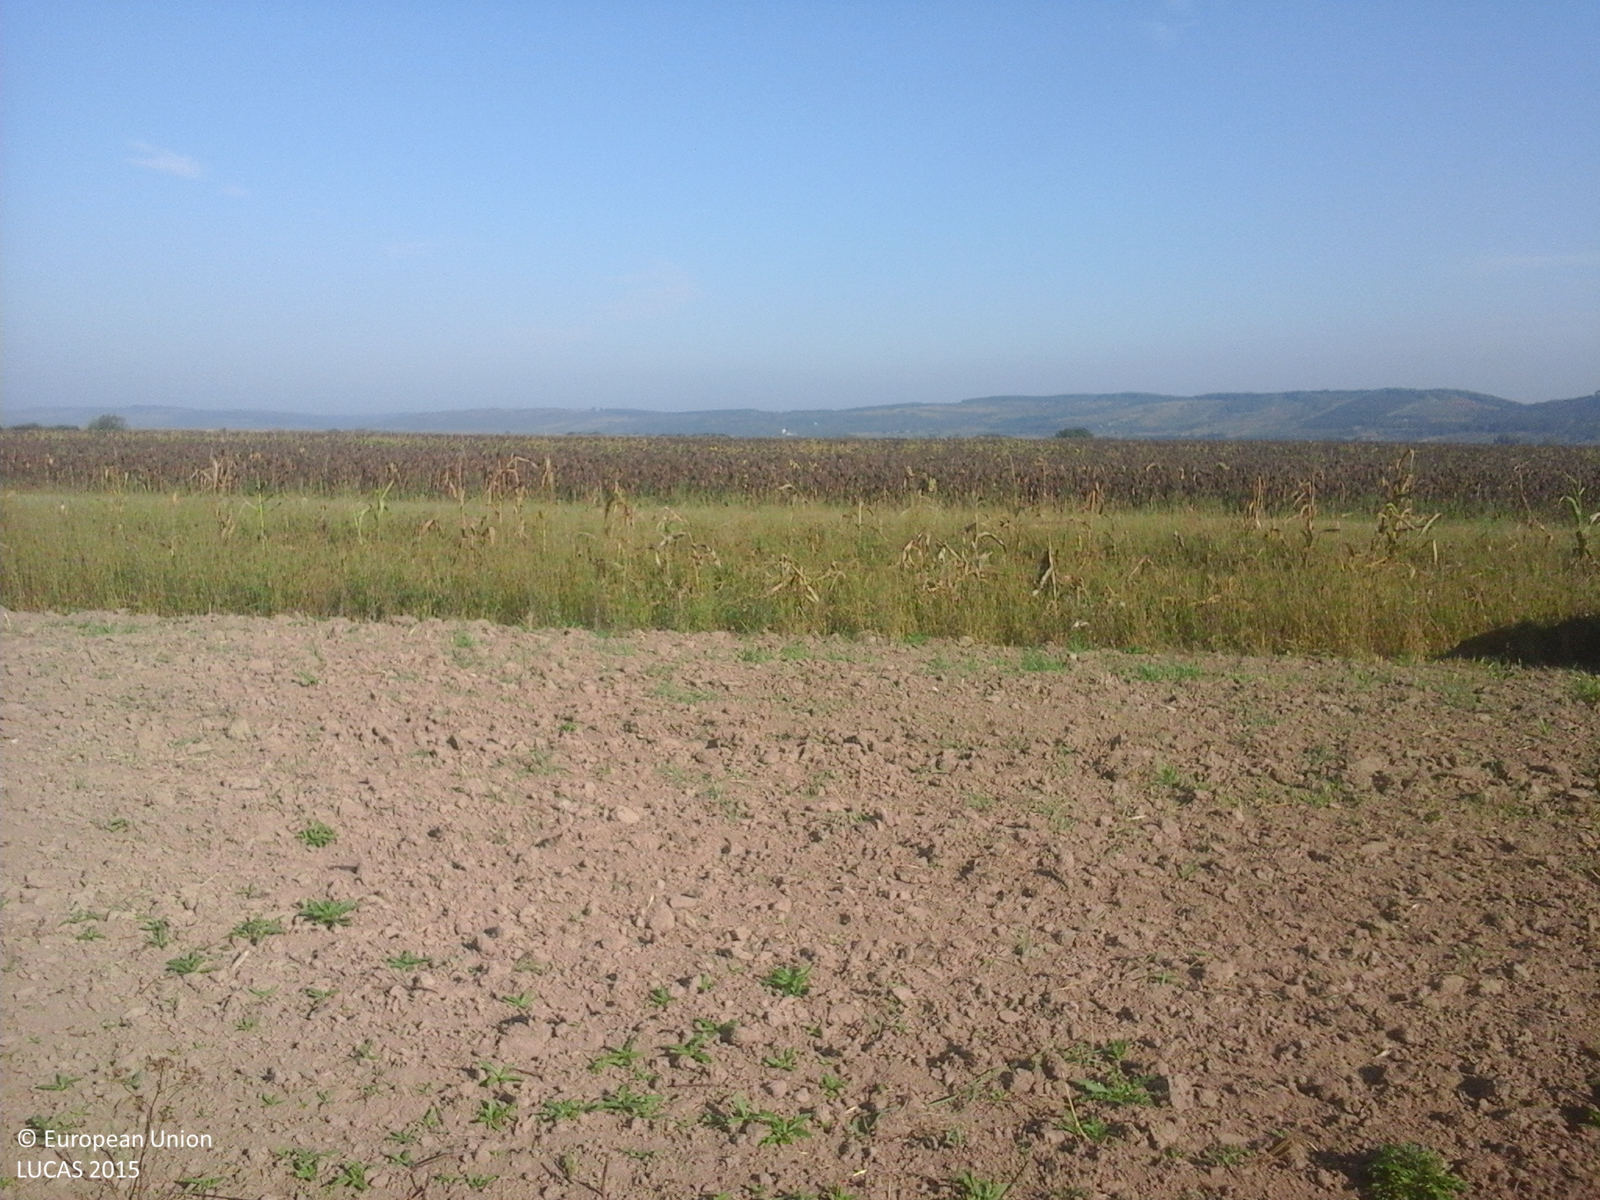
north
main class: Grassland
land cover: Spontaneously vegetated surfaces
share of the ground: > 75 %
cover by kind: herbaceous plants 100 %
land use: Agriculture (excluding fallow land and kitchen gardens)
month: September
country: RO
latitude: 47.1952
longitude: 22.6899
